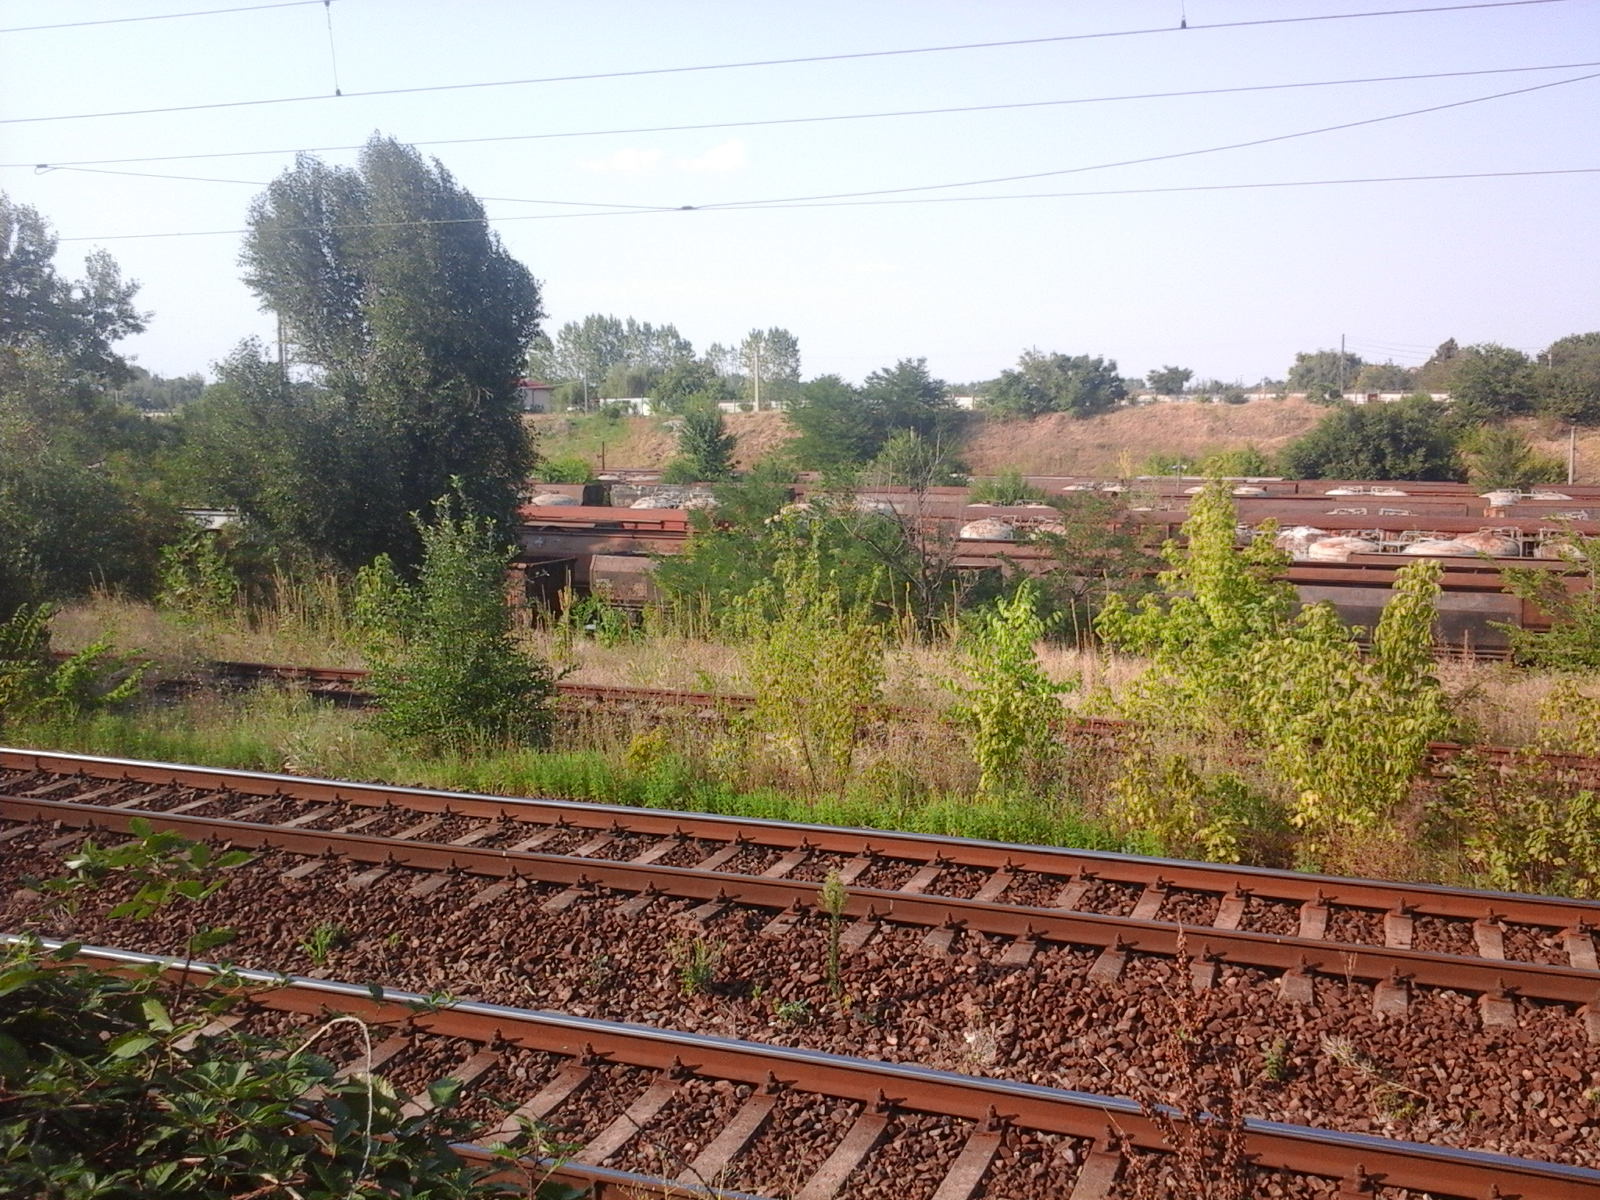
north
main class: Woodland
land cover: Broadleaved woodland
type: exotic forest
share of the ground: > 75 %
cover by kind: broadleaved forest trees 100 %
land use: Semi-natural and natural areas not in use
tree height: > 5 m
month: August
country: RO
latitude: 44.3385
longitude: 23.7907
